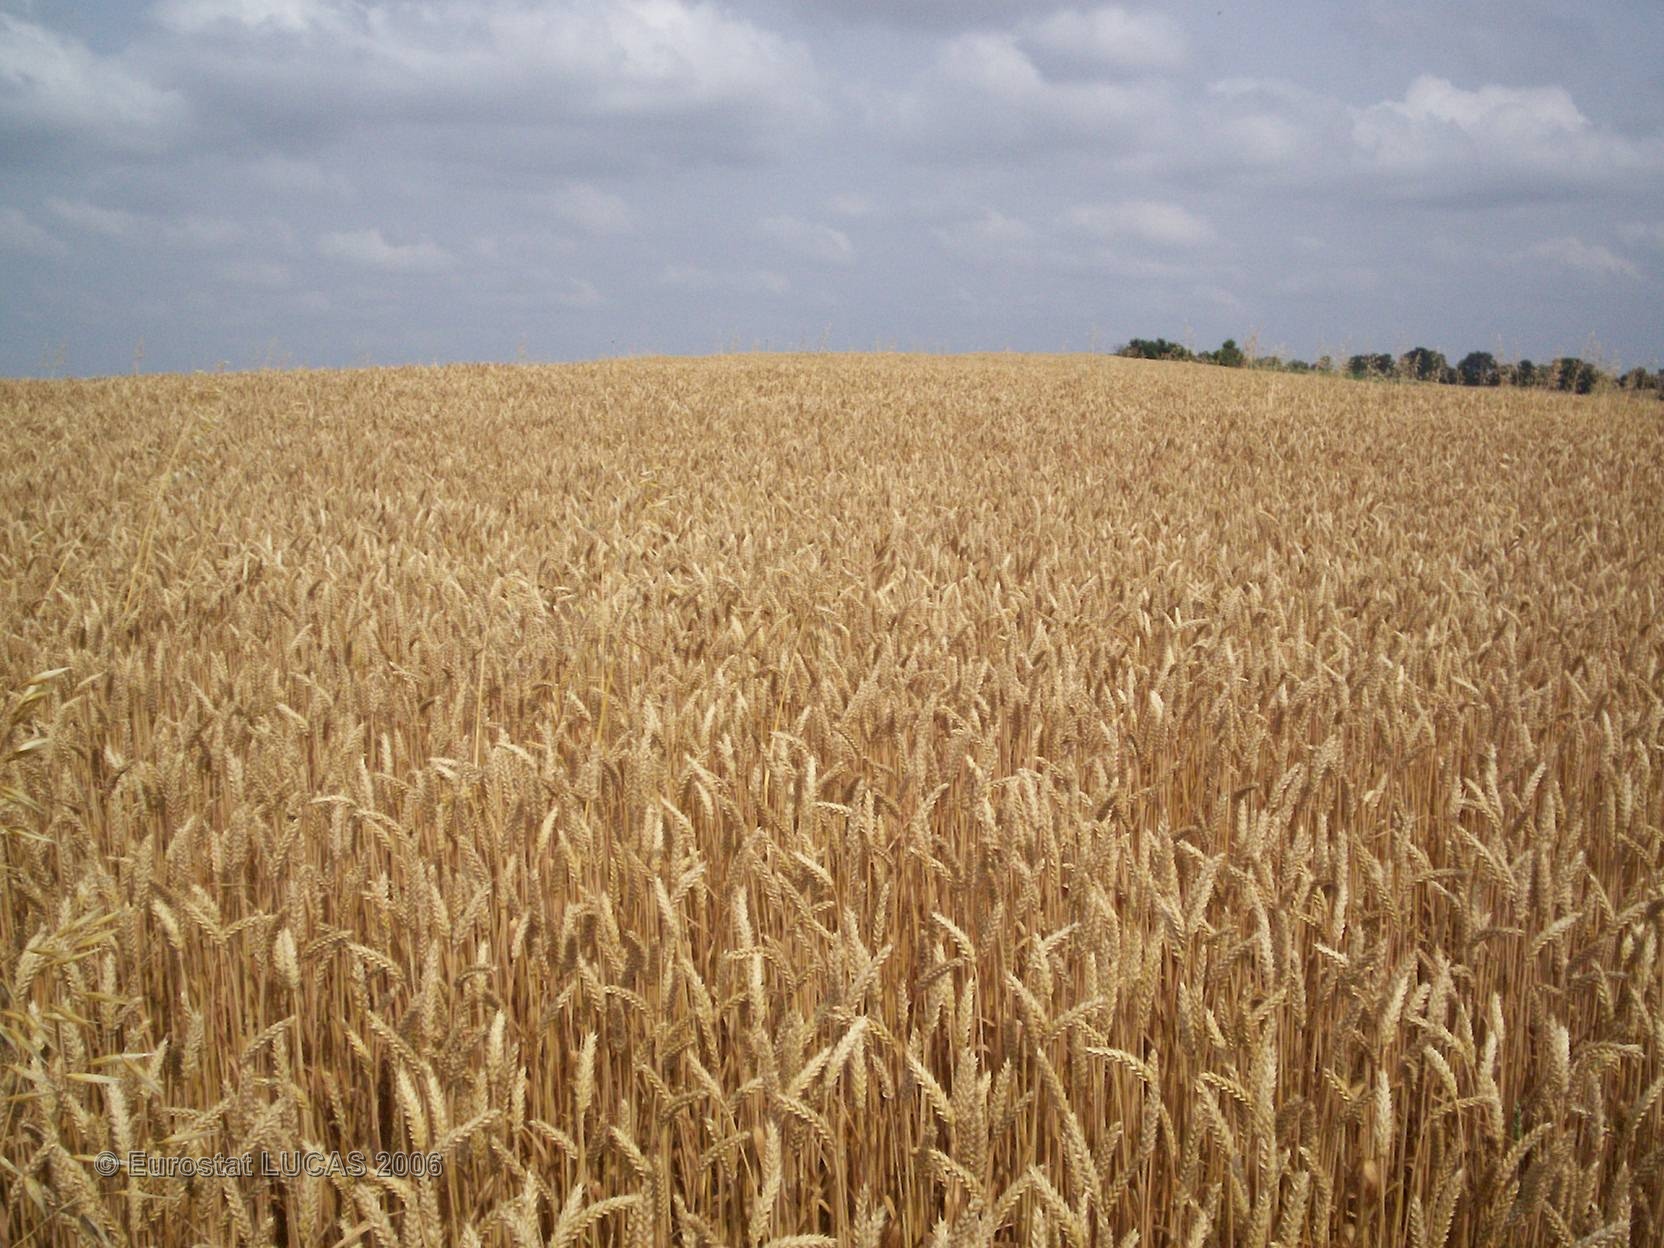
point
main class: Cropland
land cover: Common wheat
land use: Agriculture (excluding fallow land and kitchen gardens)
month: June
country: FR
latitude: 43.6893
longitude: 1.0303
